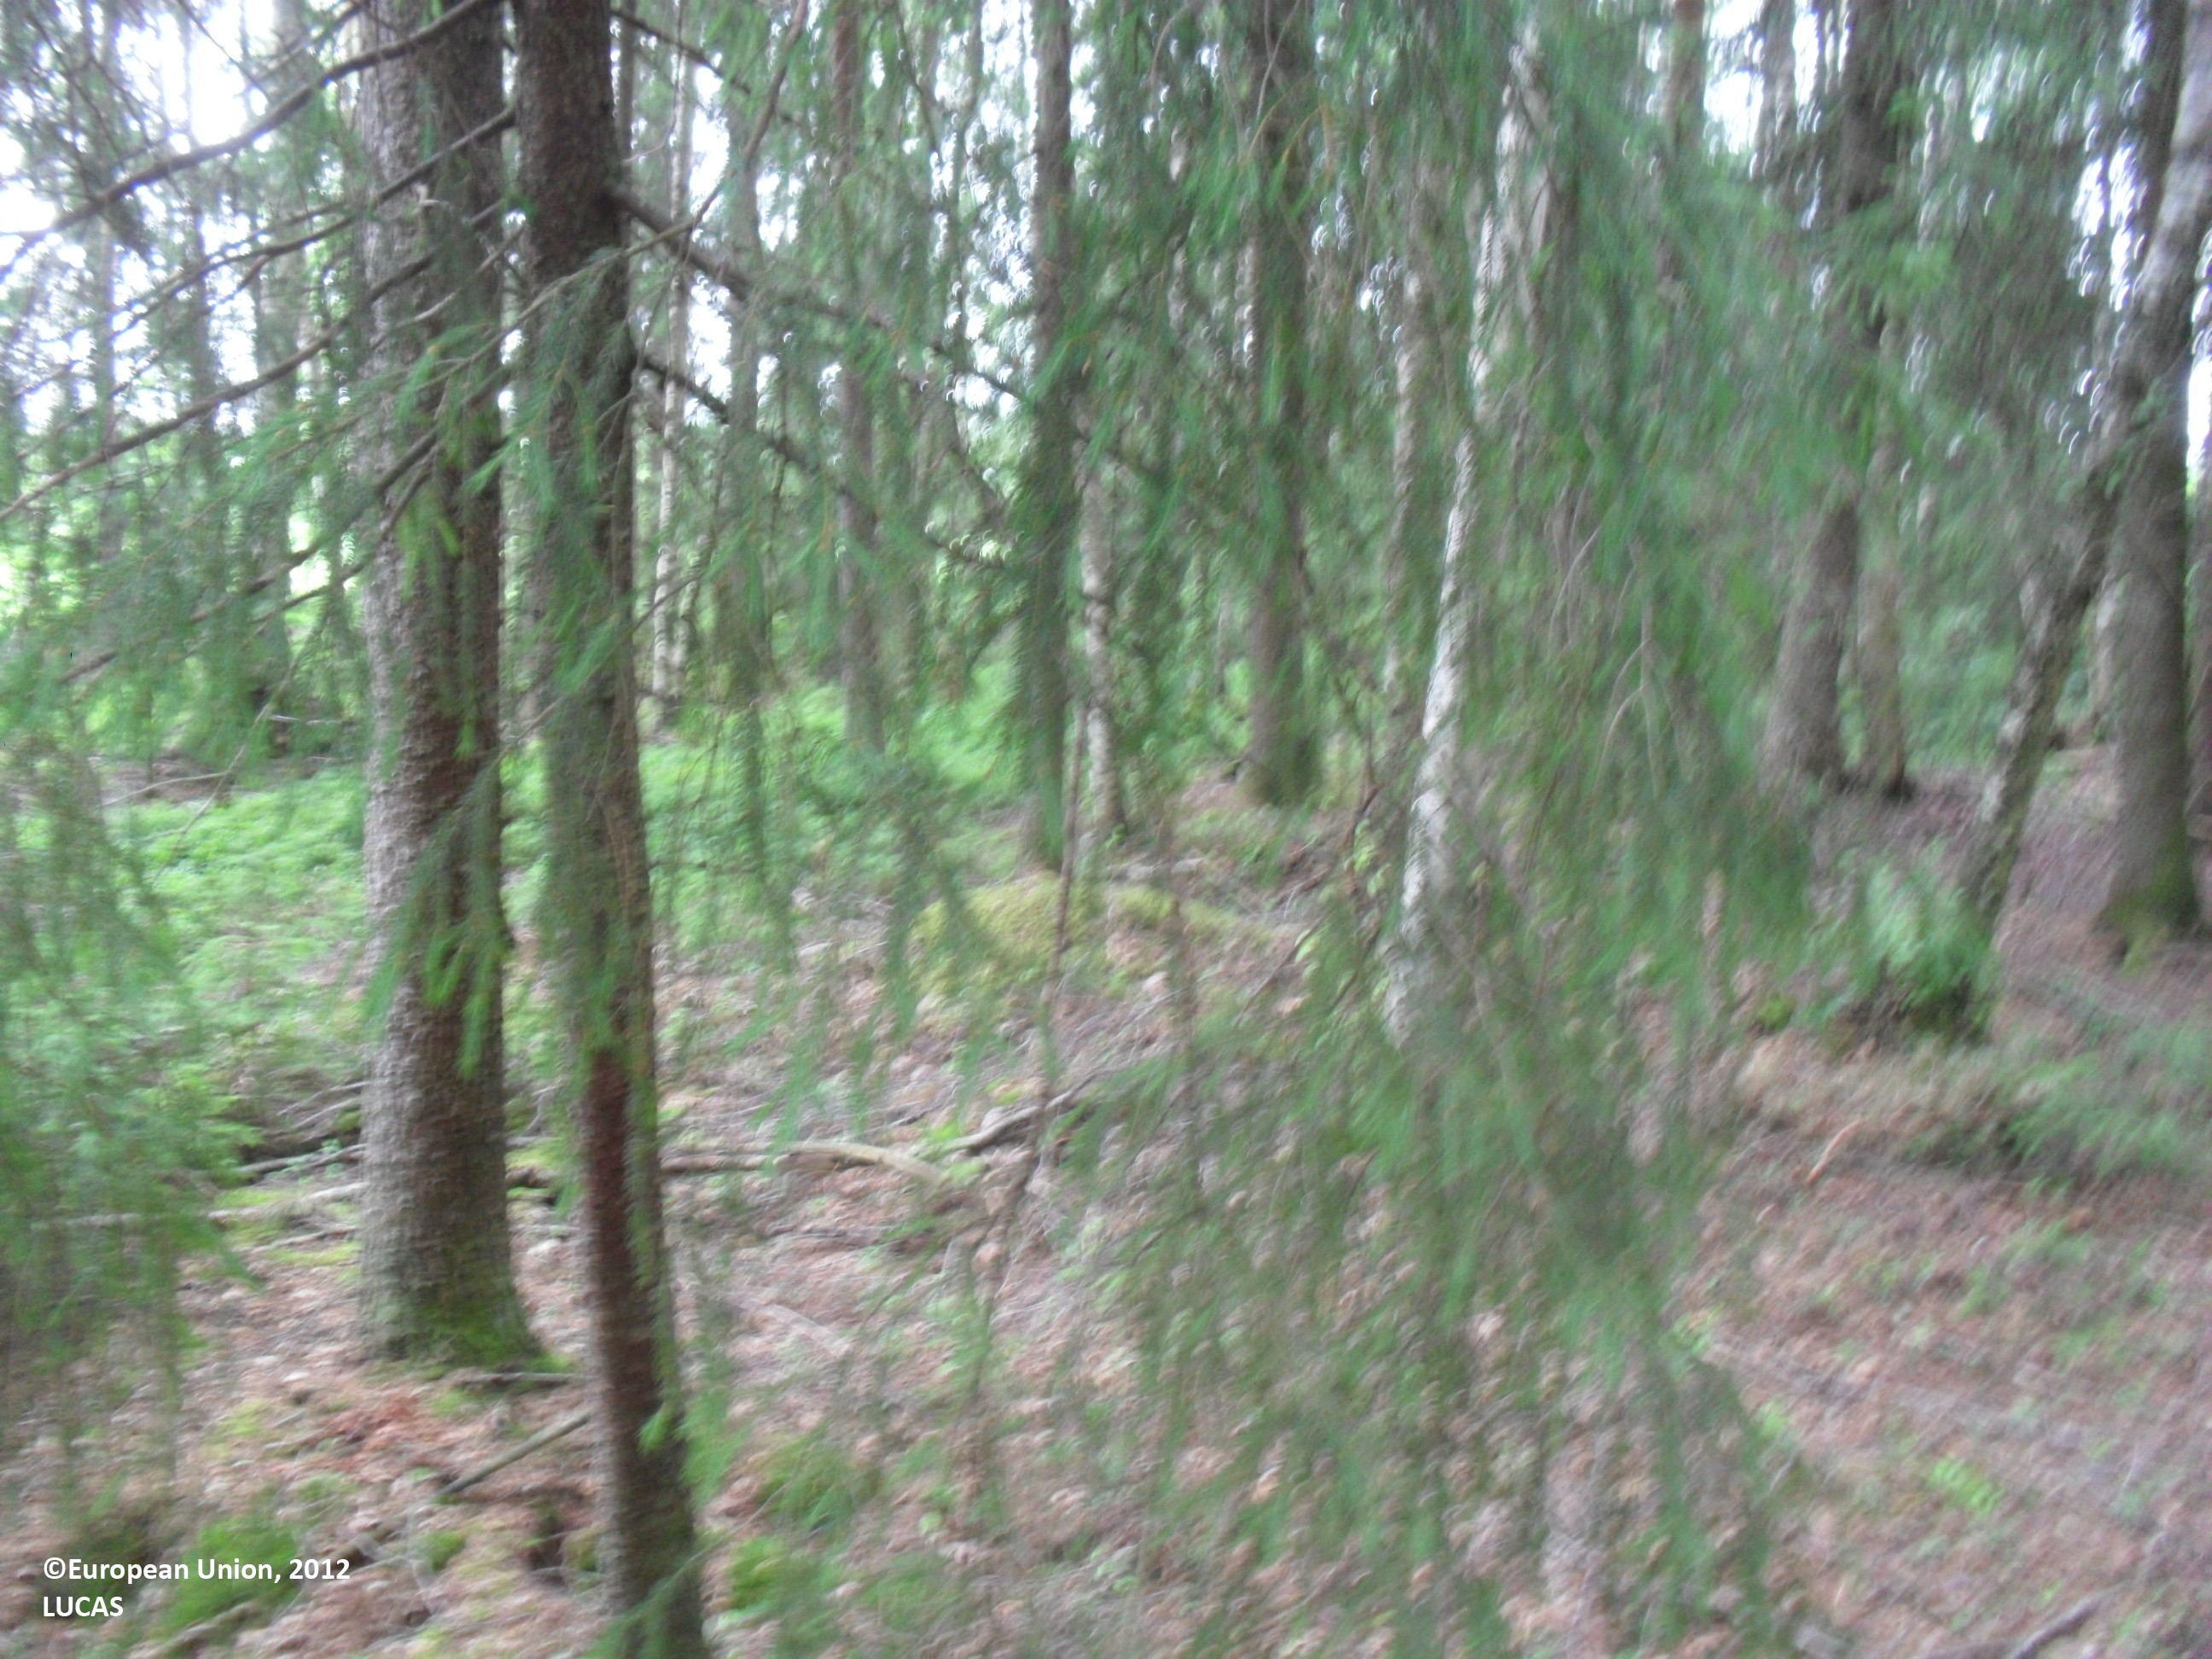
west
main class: Woodland
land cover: Spruce dominated mixed woodland
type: boreal forest
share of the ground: 50 - 75 %
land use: Forestry
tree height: > 5 m
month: July
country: FI
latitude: 63.6324
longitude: 23.5219
